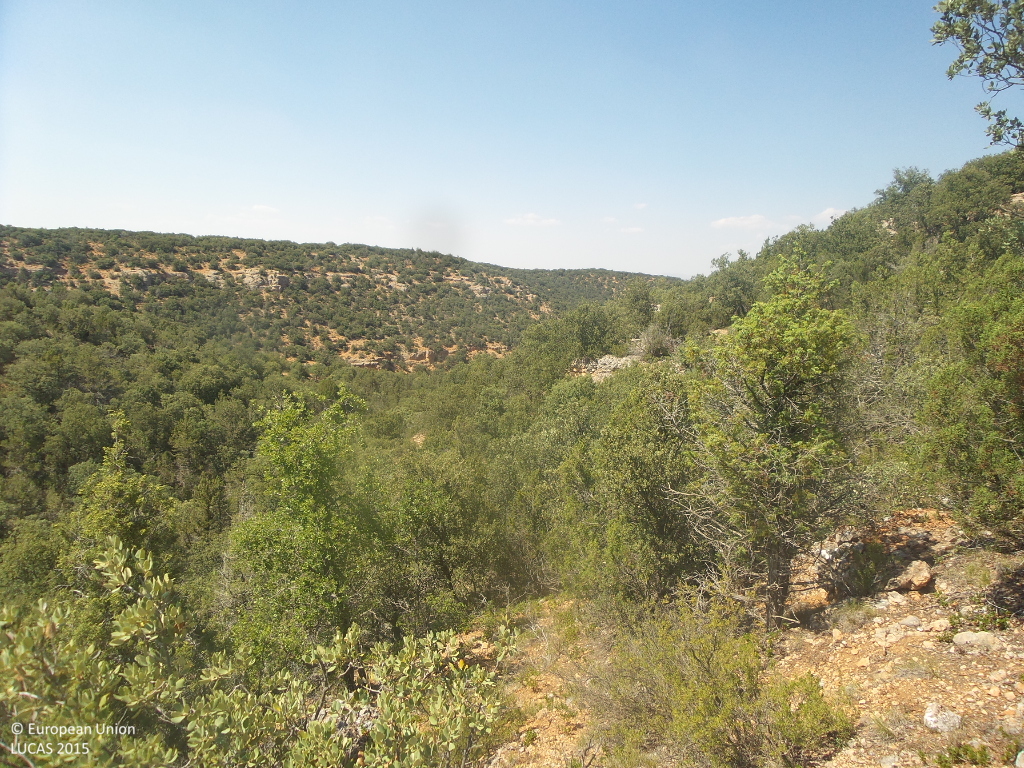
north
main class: Woodland
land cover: Broadleaved woodland
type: broadleaved evergreen forest
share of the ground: > 75 %
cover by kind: broadleaved forest trees 80 %, unconsolidated bare surface 10 %, shrubs 5 %, herbaceous plants 5 %
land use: Semi-natural and natural areas not in use
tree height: > 5 m
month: July
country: ES
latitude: 41.1536
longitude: -2.1468
